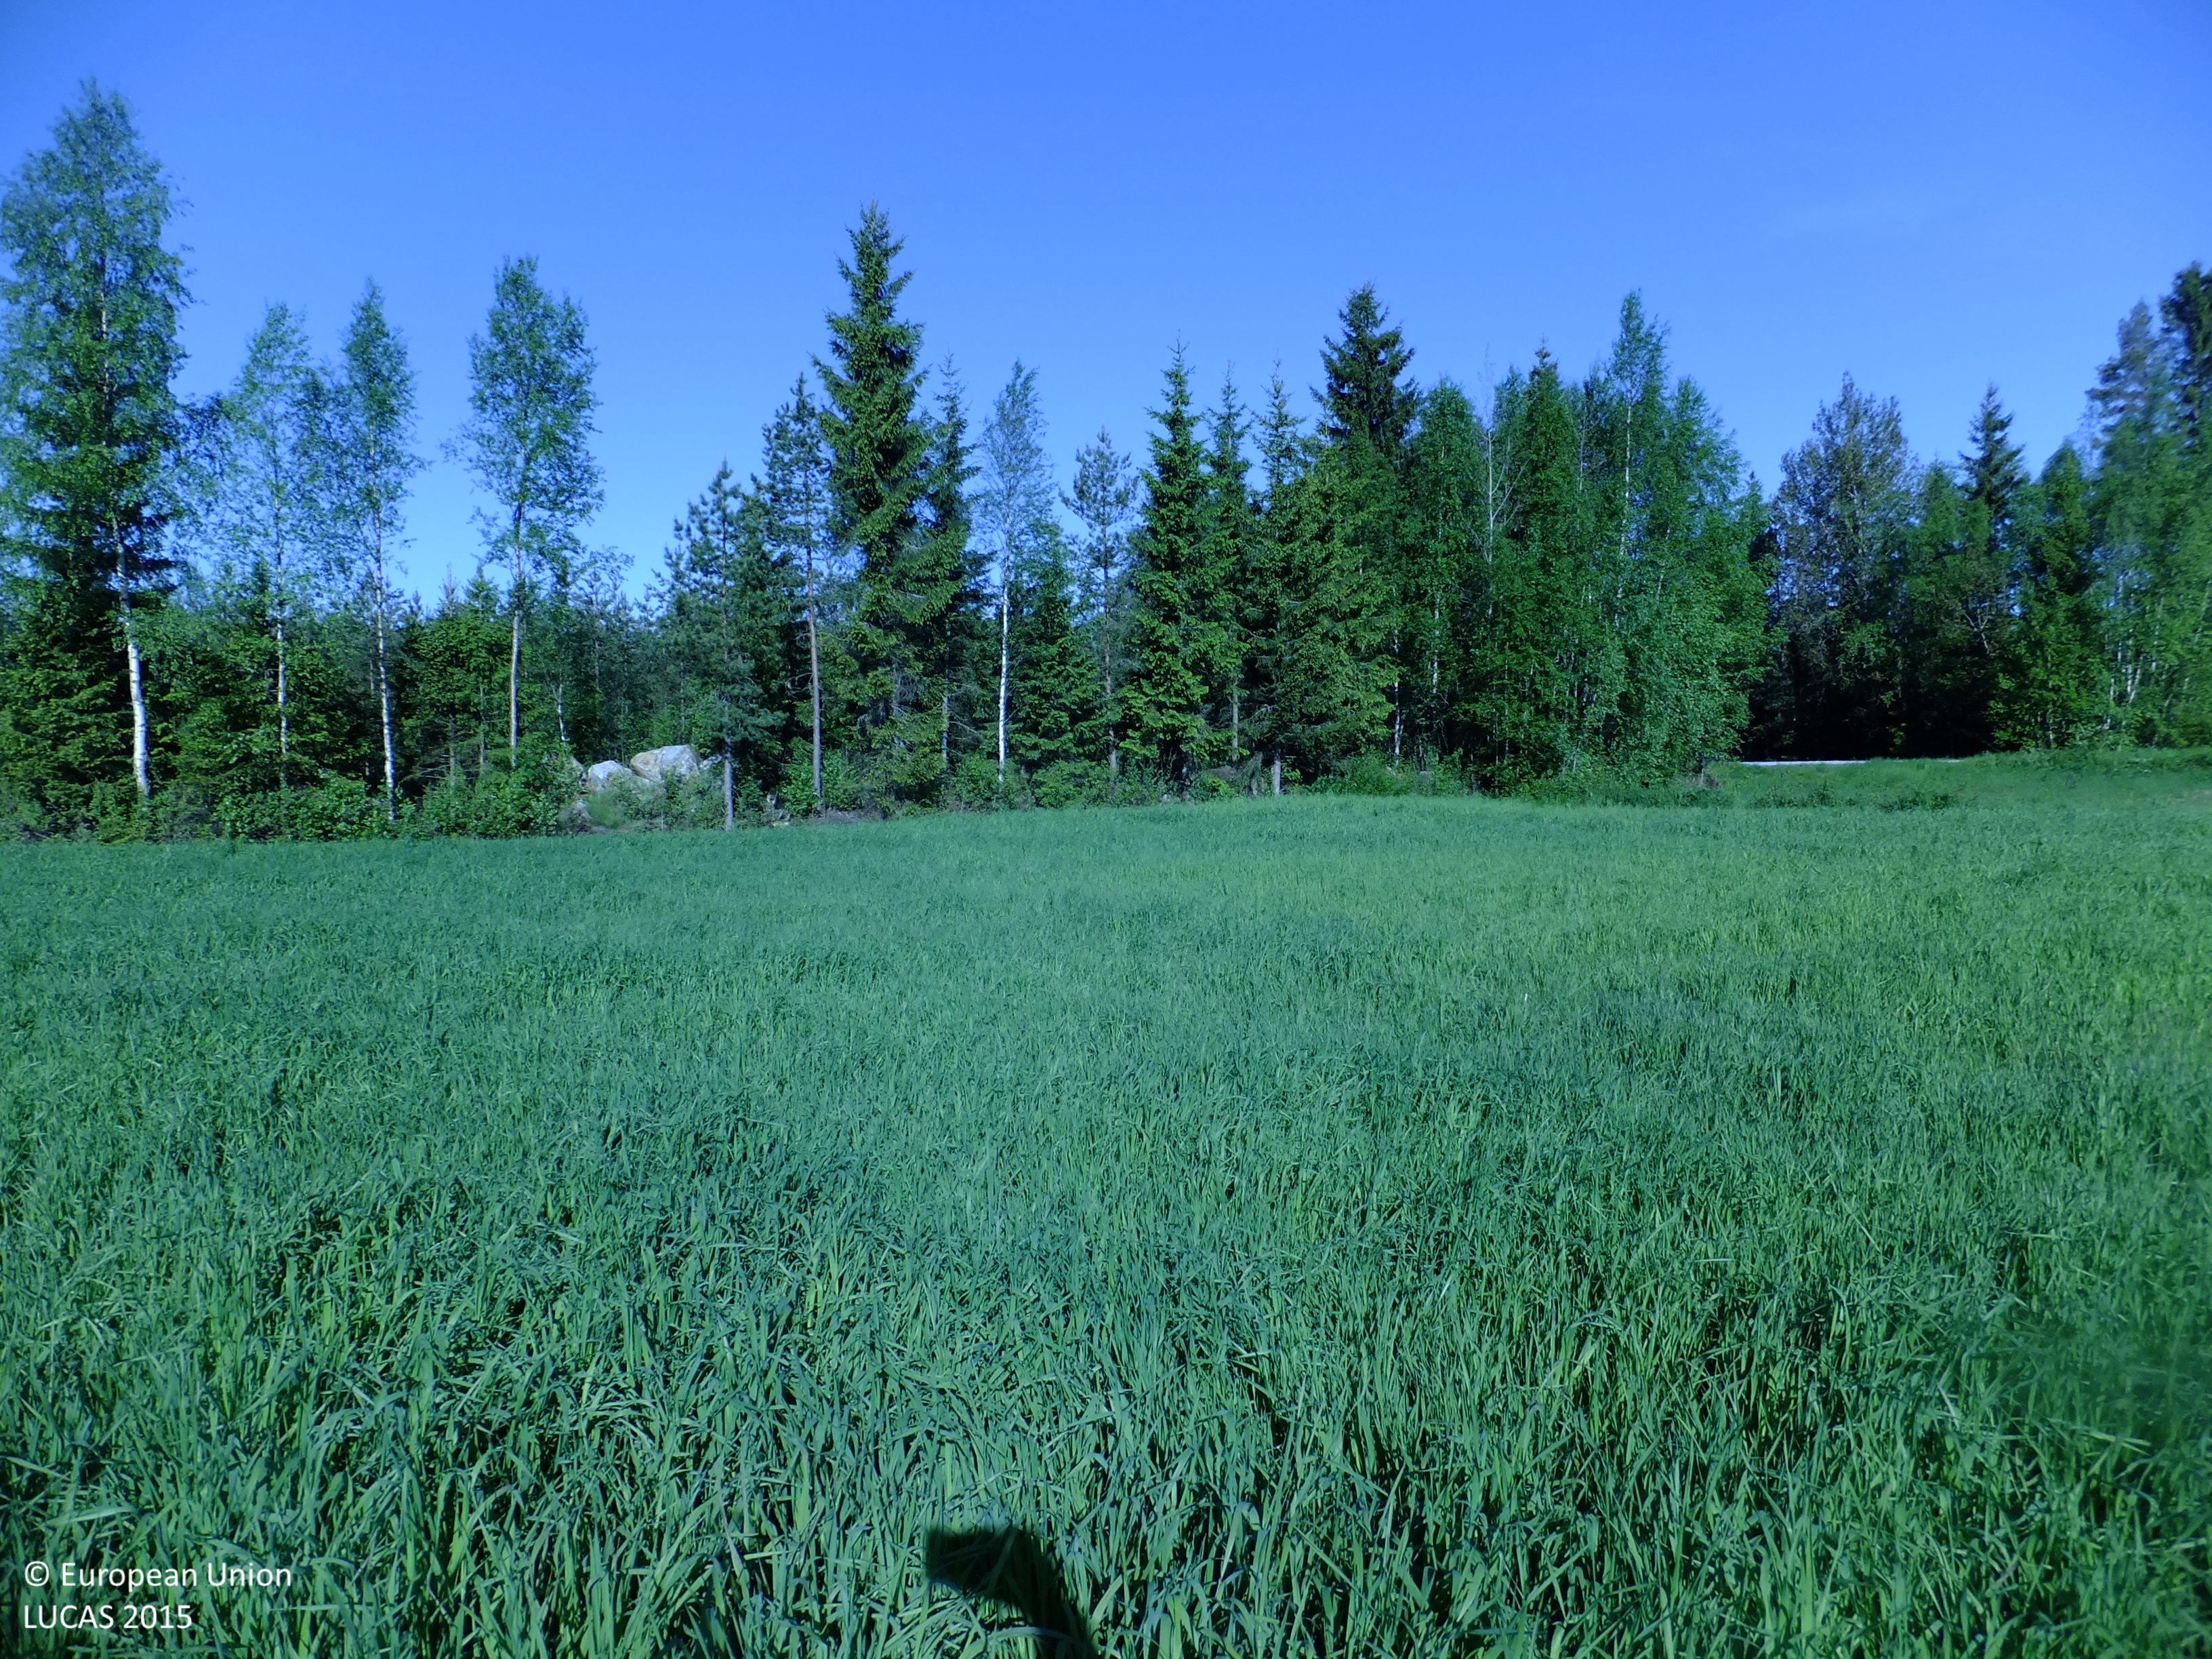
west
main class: Cropland
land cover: Temporary grasslands
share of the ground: > 75 %
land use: Agriculture (excluding fallow land and kitchen gardens)
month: June
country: FI
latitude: 63.4520
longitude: 22.6233
